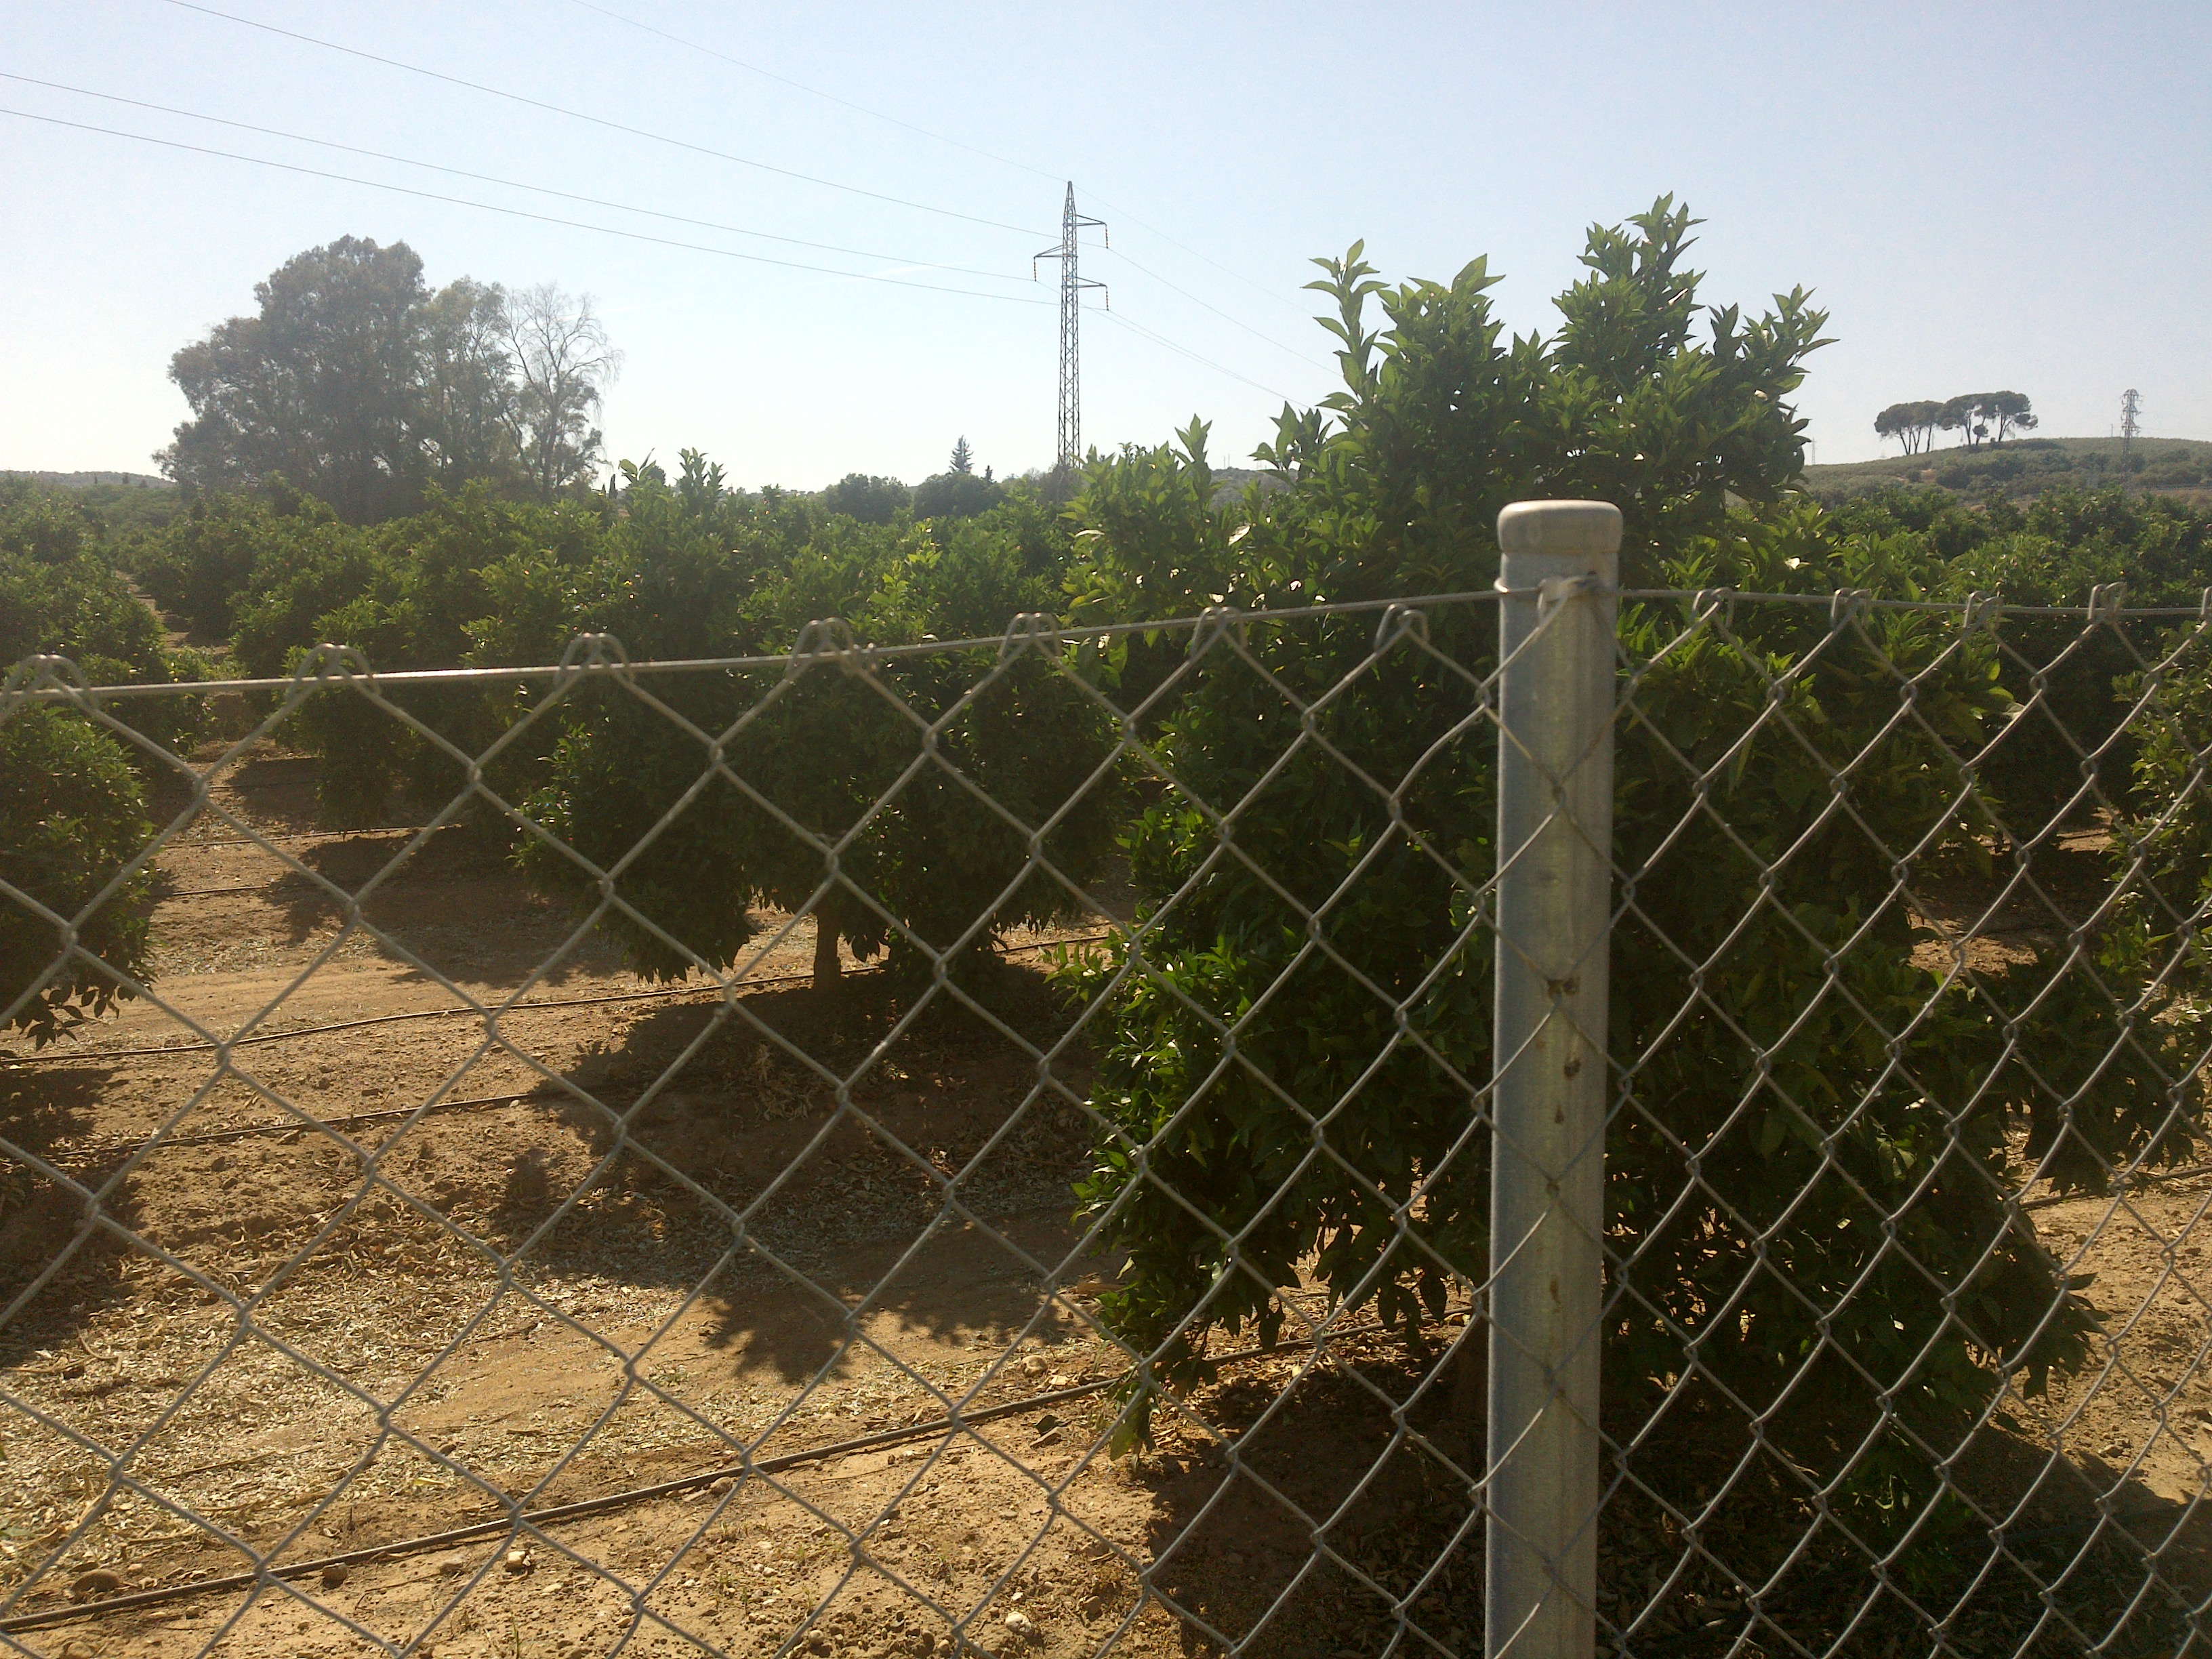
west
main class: Cropland
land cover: Oranges
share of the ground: 50 - 75 %
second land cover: Other bare soil
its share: > 75 %
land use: Agriculture (excluding fallow land and kitchen gardens)
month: May
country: ES
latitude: 37.8201
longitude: -5.0005
